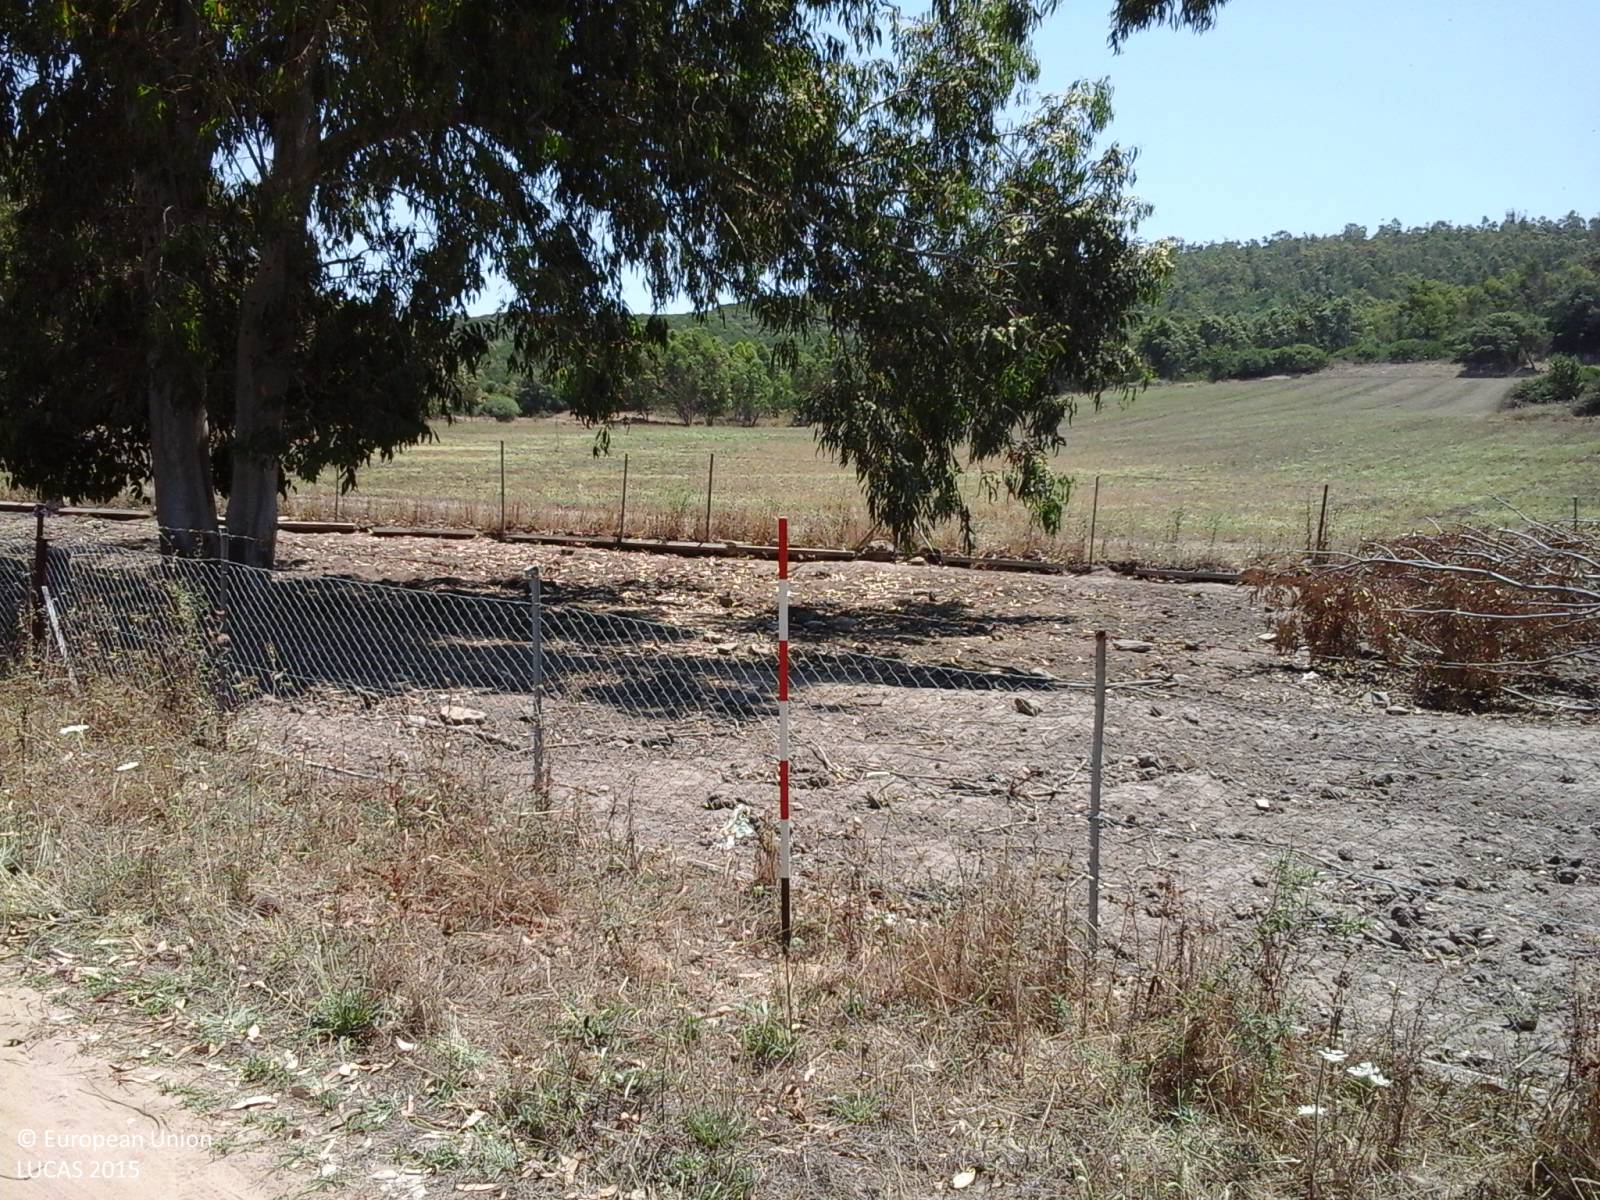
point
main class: Woodland
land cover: Broadleaved woodland
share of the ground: > 75 %
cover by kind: broadleaved forest trees 50 %, unconsolidated bare surface 40 %, herbaceous plants 10 %
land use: Agriculture (excluding fallow land and kitchen gardens)
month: June
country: IT
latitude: 39.8619
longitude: 8.8259
